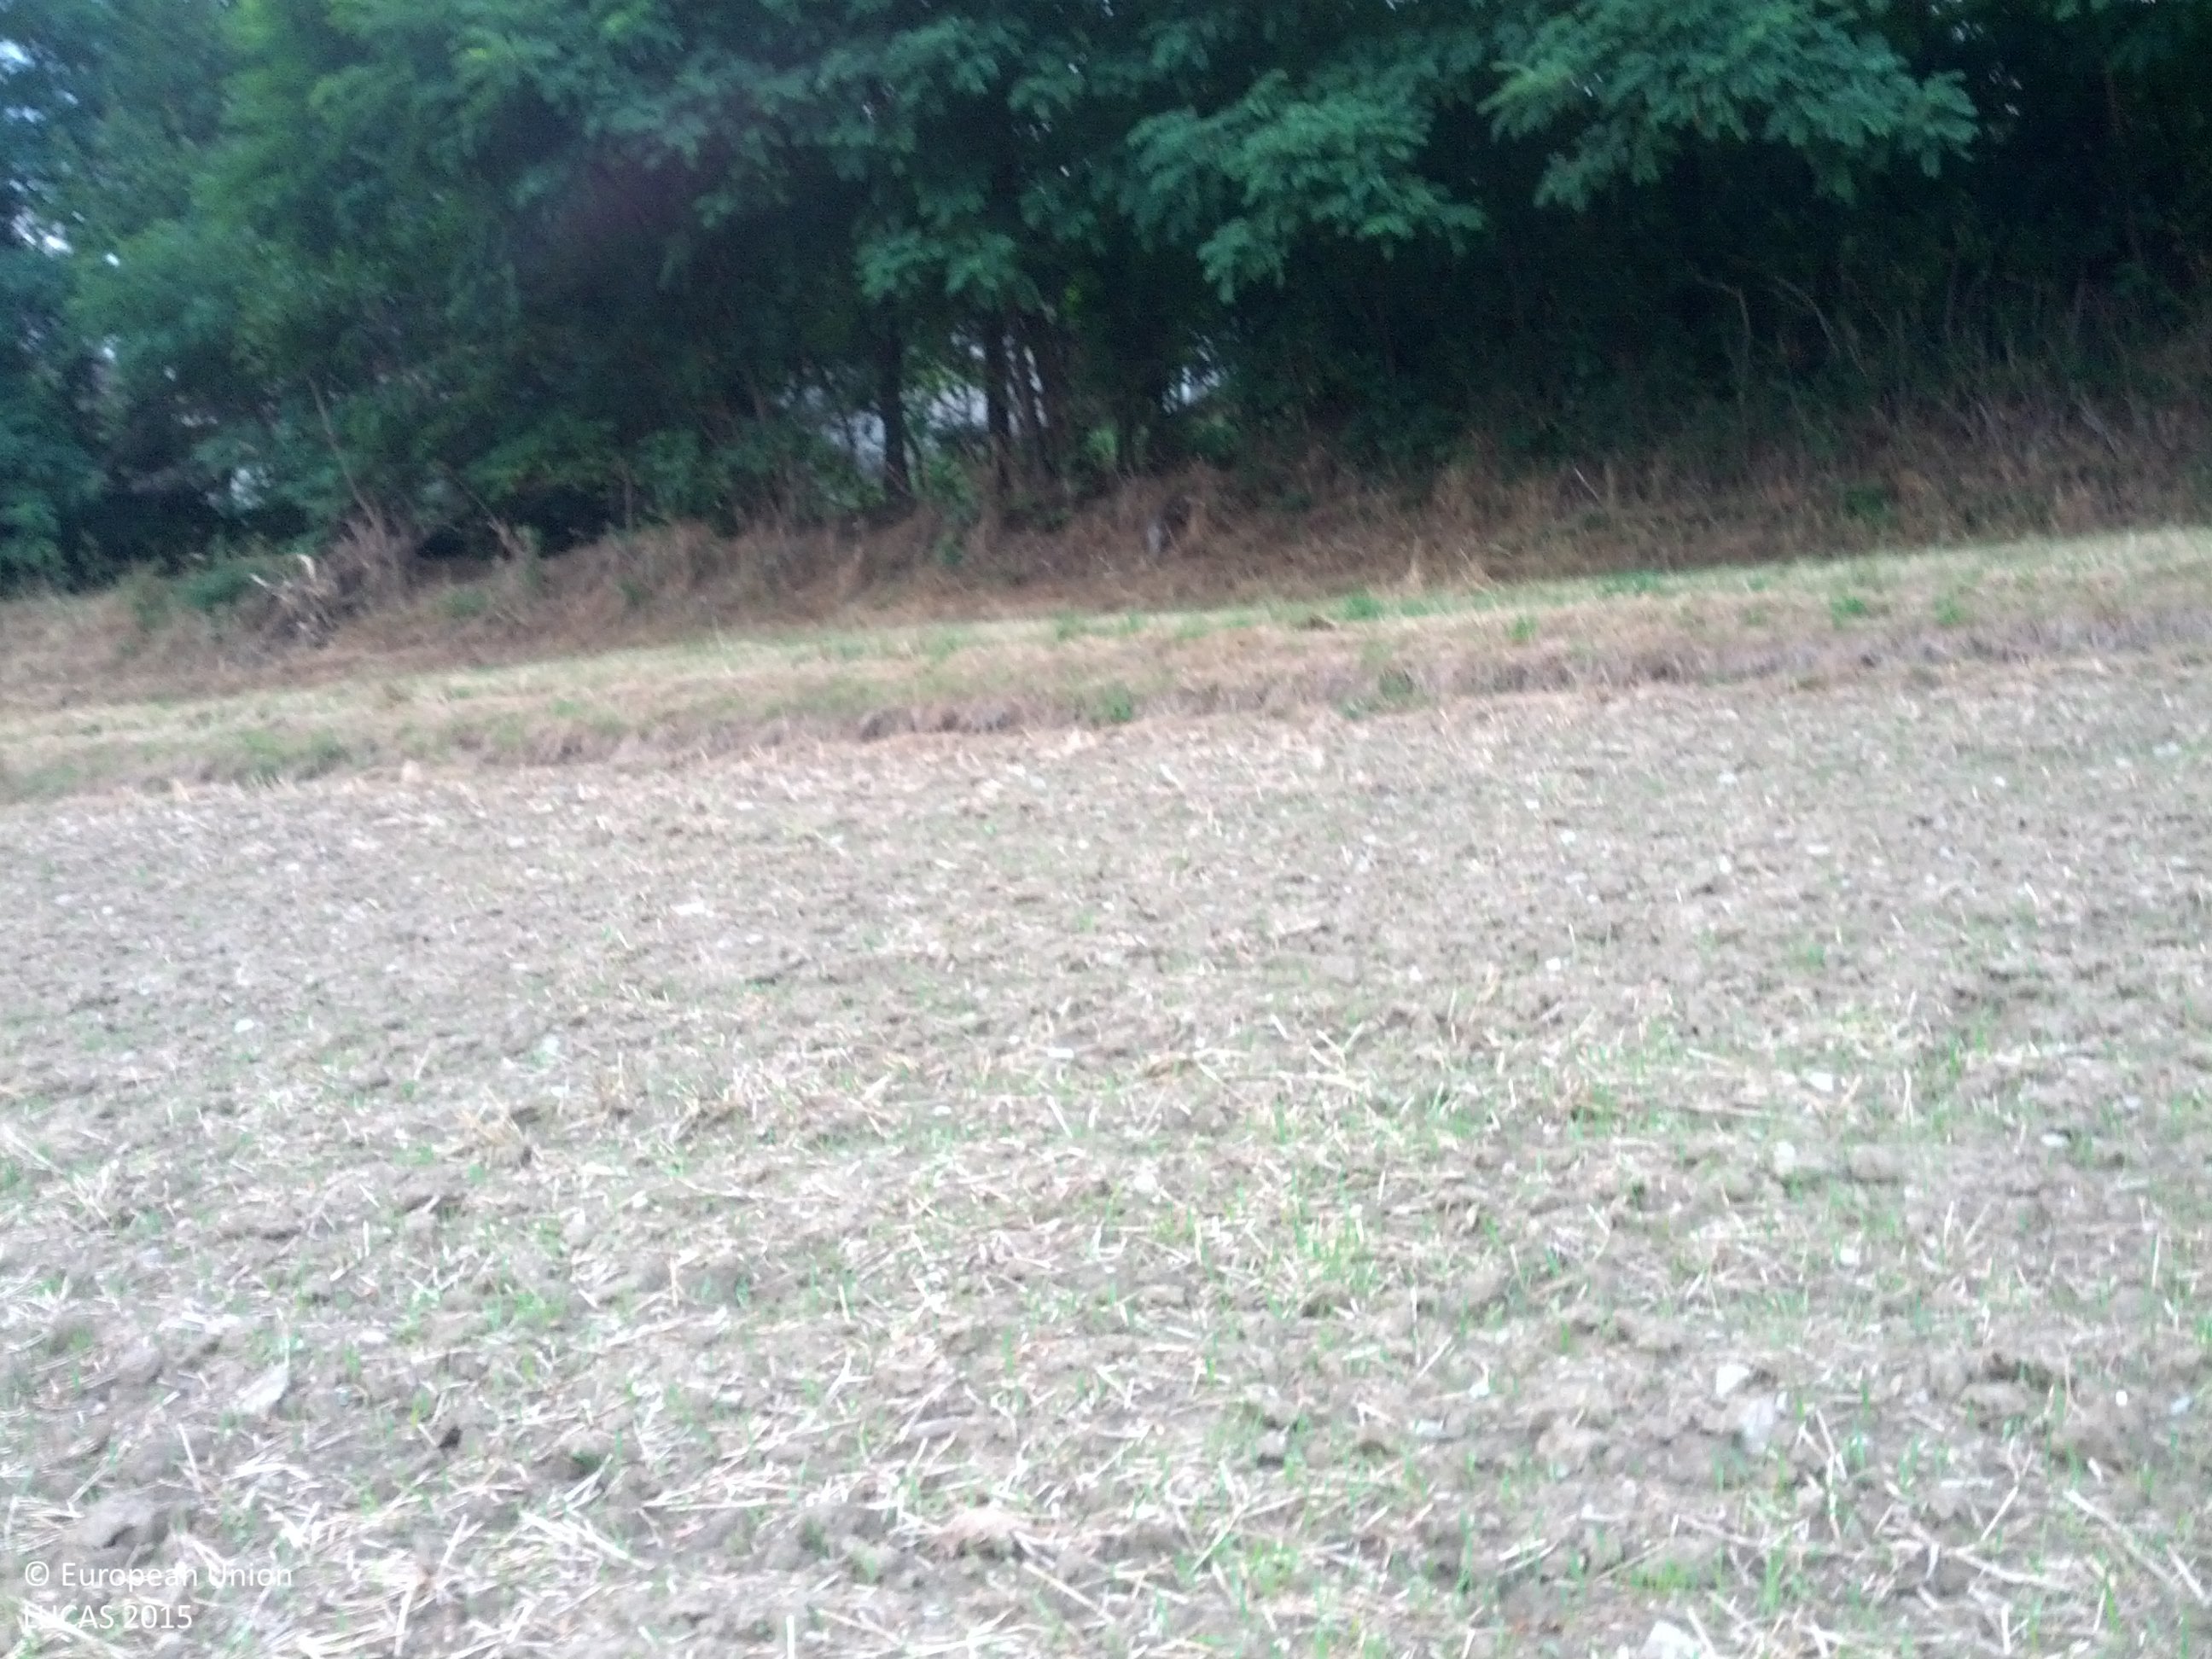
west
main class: Cropland
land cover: Barley
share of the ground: < 10 %
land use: Agriculture (excluding fallow land and kitchen gardens)
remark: Harvested field
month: July
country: AT
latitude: 47.3174
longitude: 16.3663
